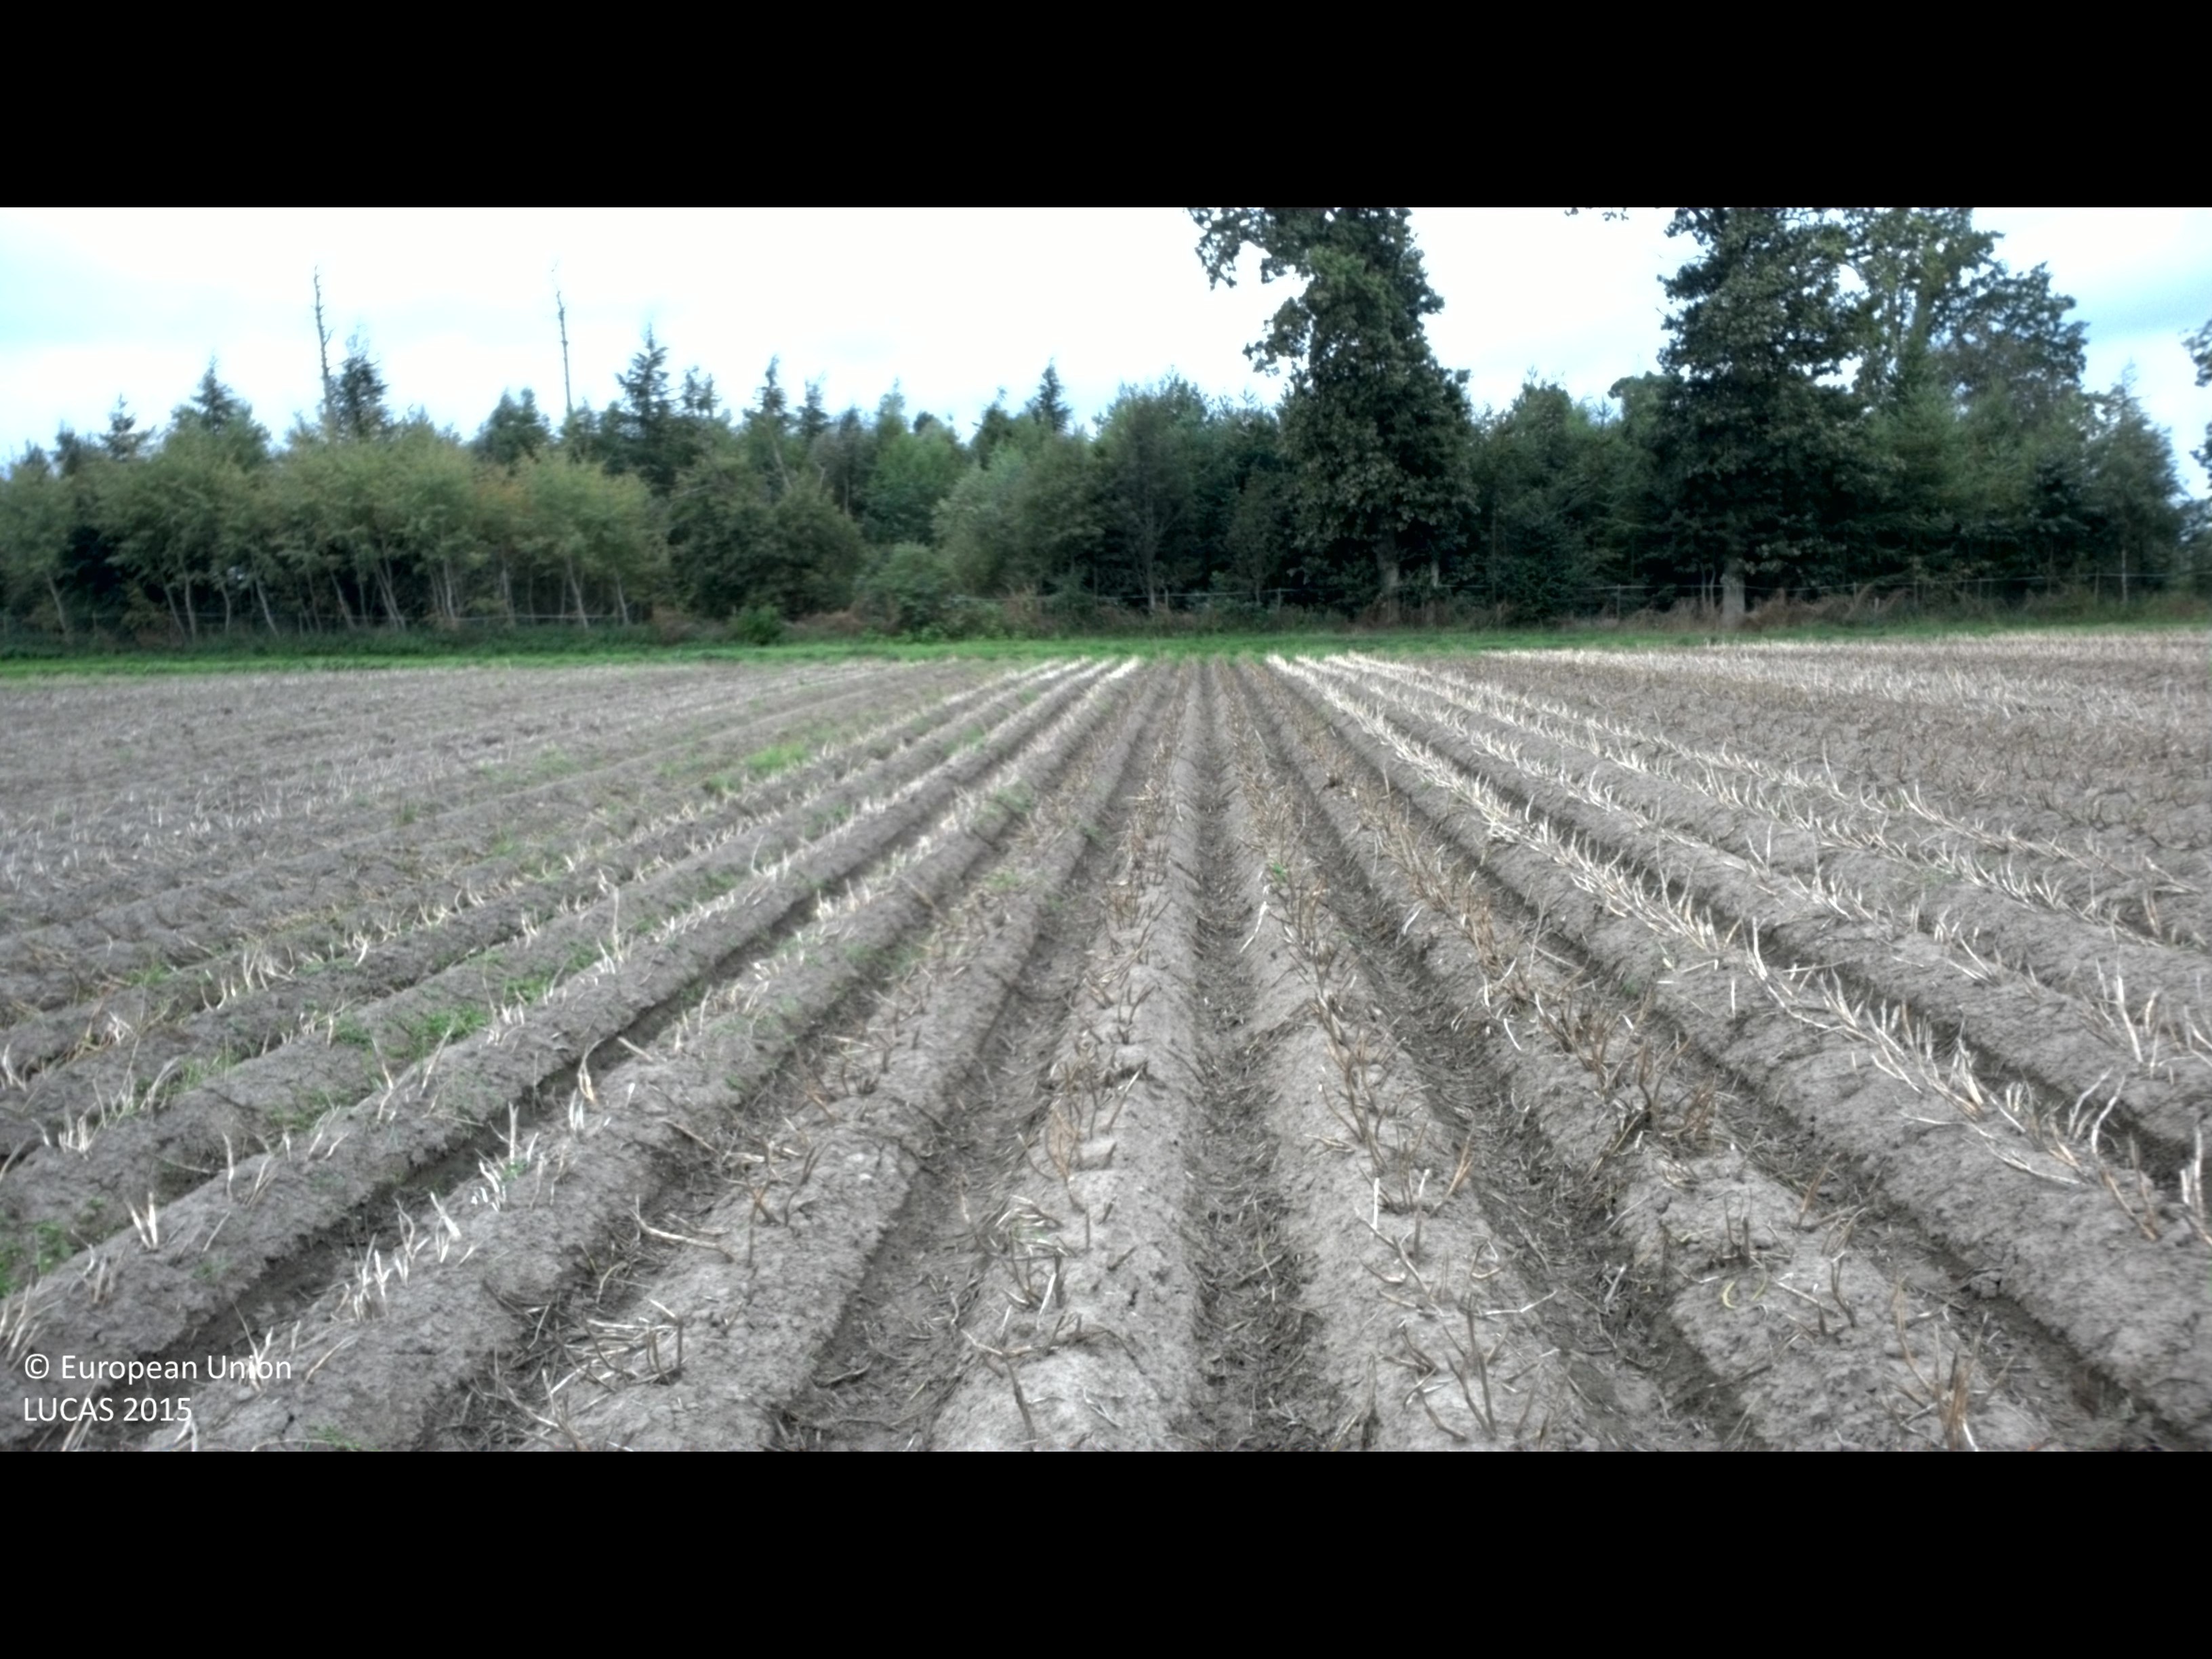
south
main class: Cropland
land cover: Potatoes
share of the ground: < 10 %
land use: Agriculture (excluding fallow land and kitchen gardens)
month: September
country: SE
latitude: 56.1762
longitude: 14.1053
